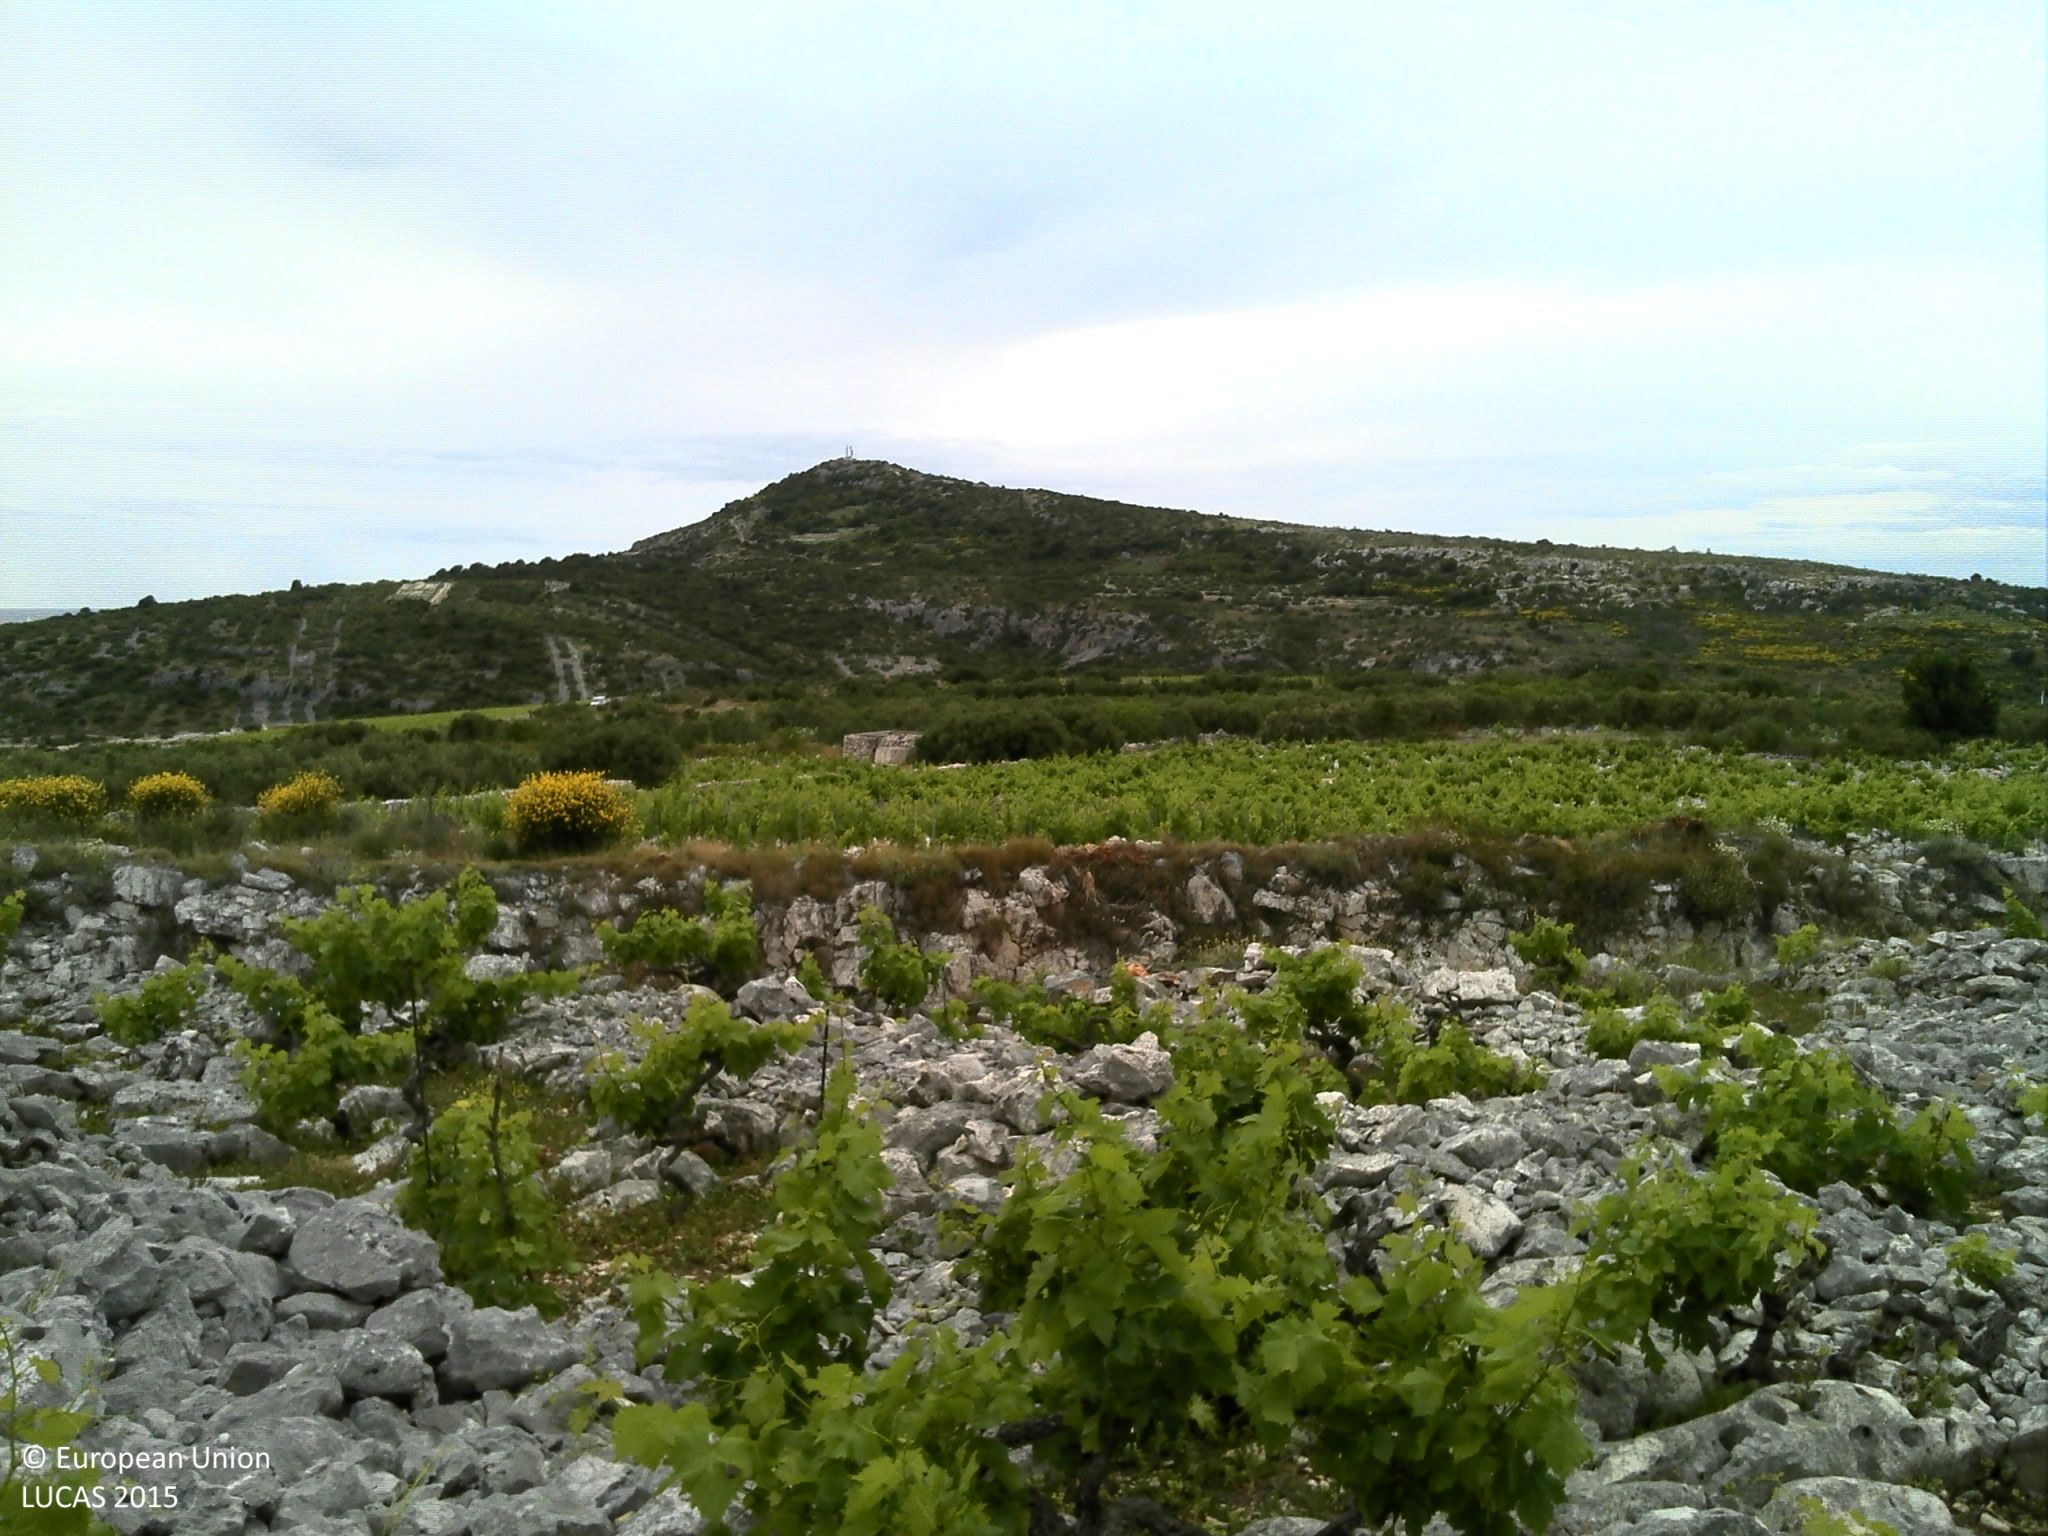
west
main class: Cropland
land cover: Vineyards
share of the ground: 25 - 50 %
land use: Agriculture (excluding fallow land and kitchen gardens)
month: May
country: HR
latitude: 43.5652
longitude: 15.9456
